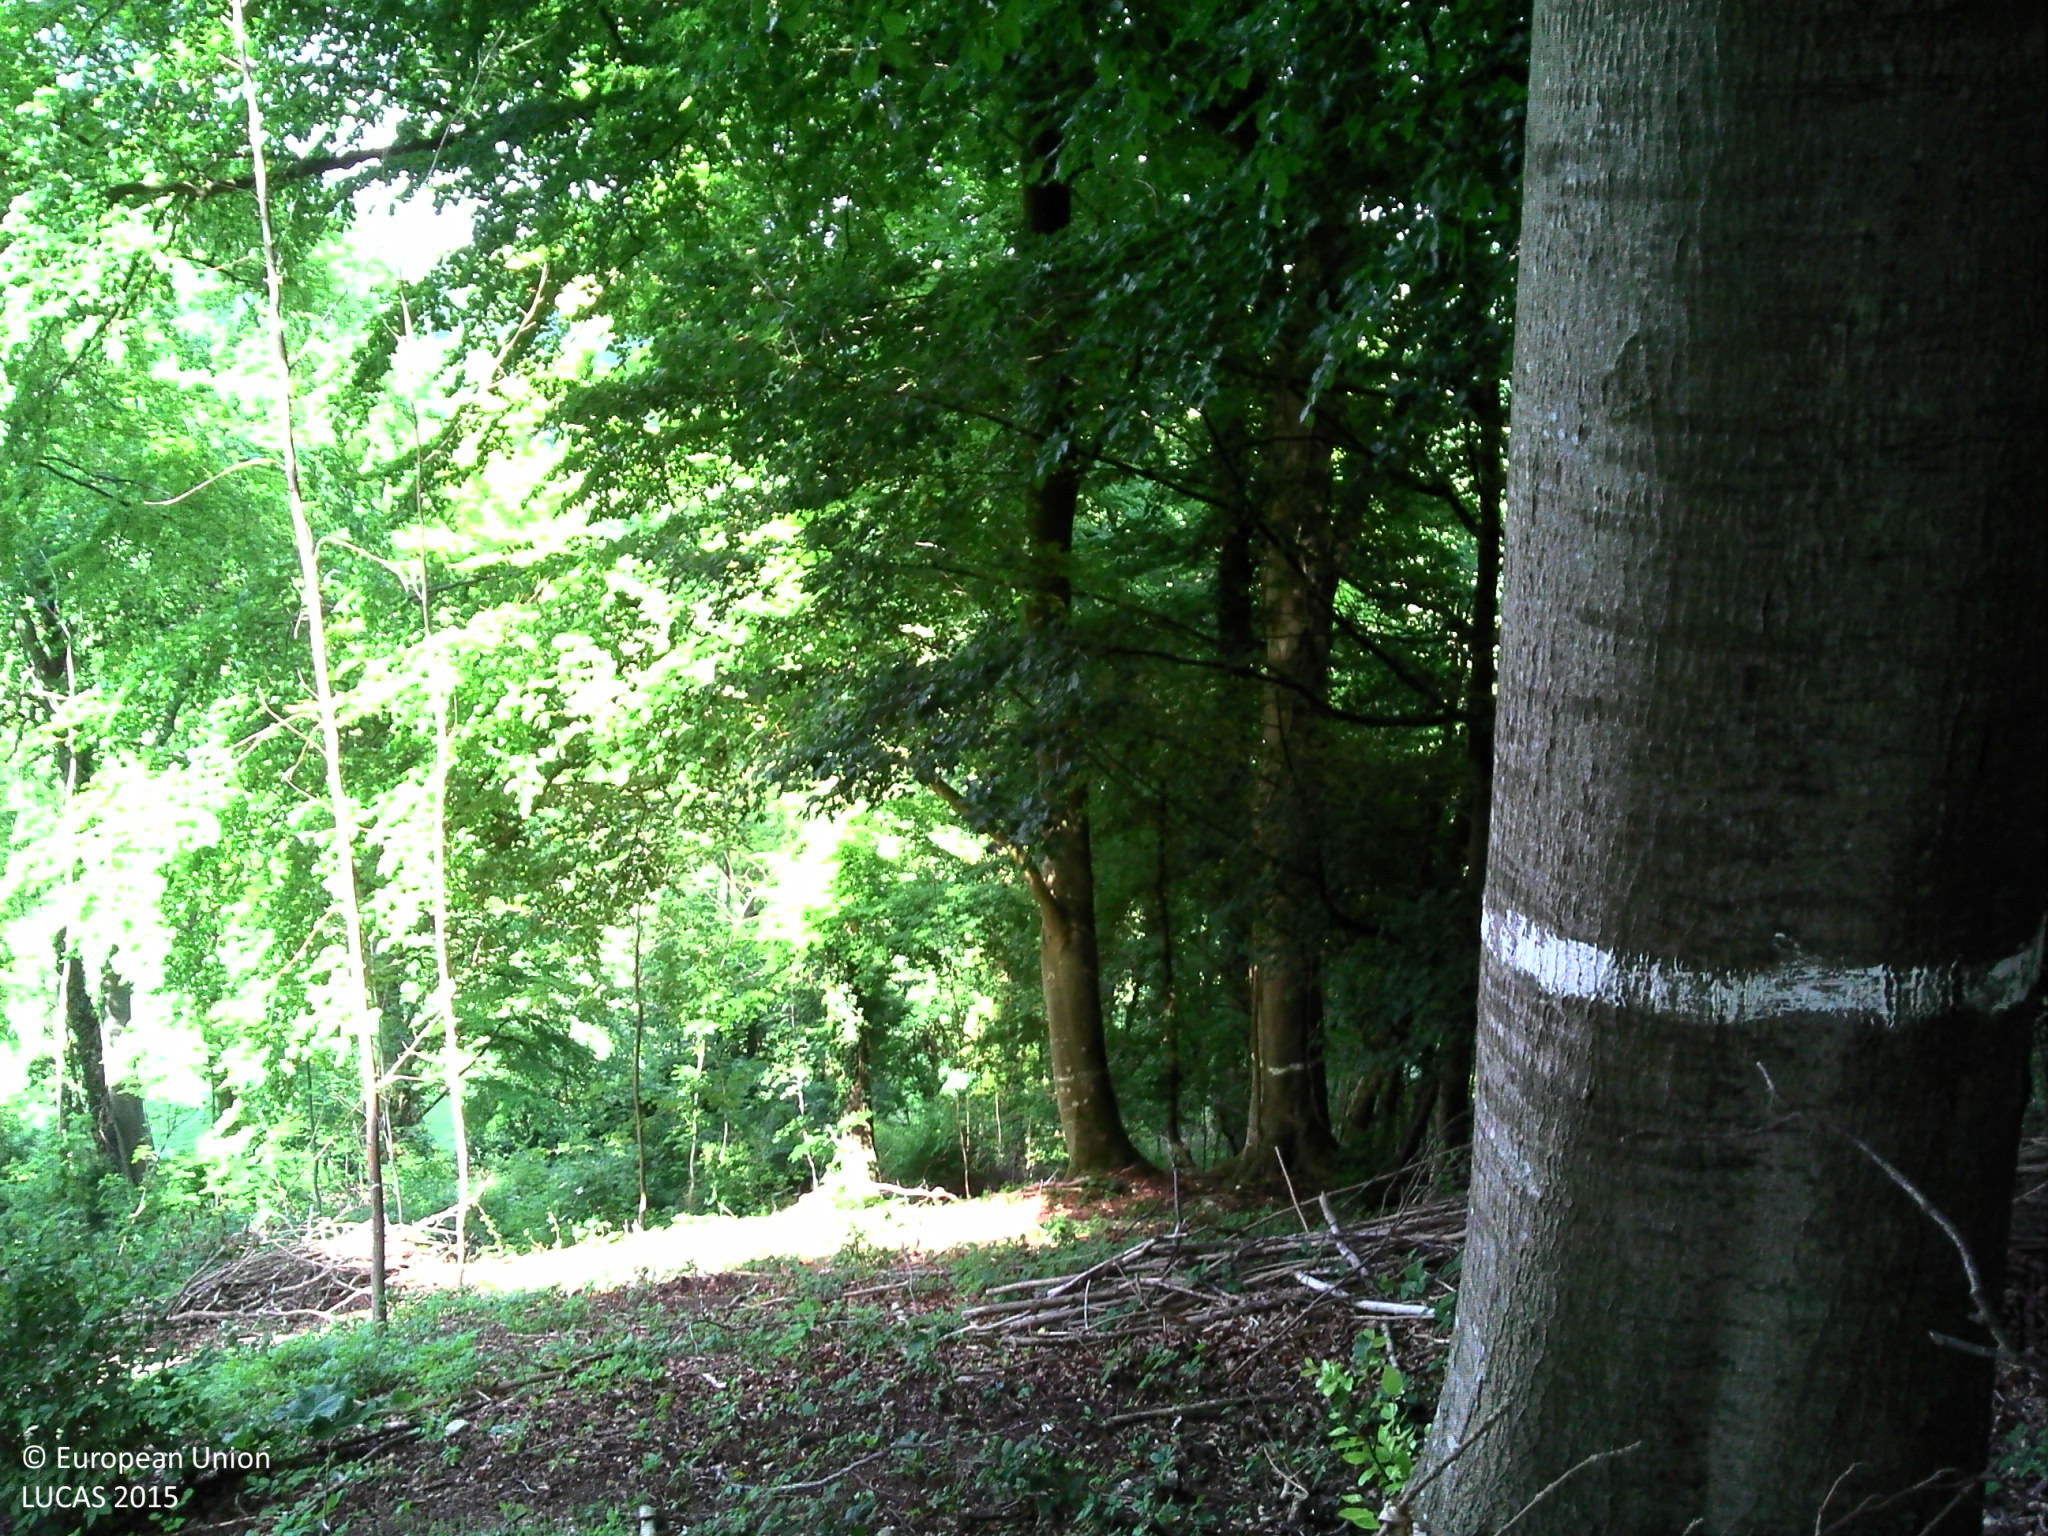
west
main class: Woodland
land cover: Broadleaved woodland
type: acidophilous oak and oak-birch forest
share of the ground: > 75 %
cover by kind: broadleaved forest trees 90 %, herbaceous plants 5 %, lichens and mosses 5 %
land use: Forestry
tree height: > 5 m
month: June
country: FR
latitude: 50.2018
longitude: 2.4075
